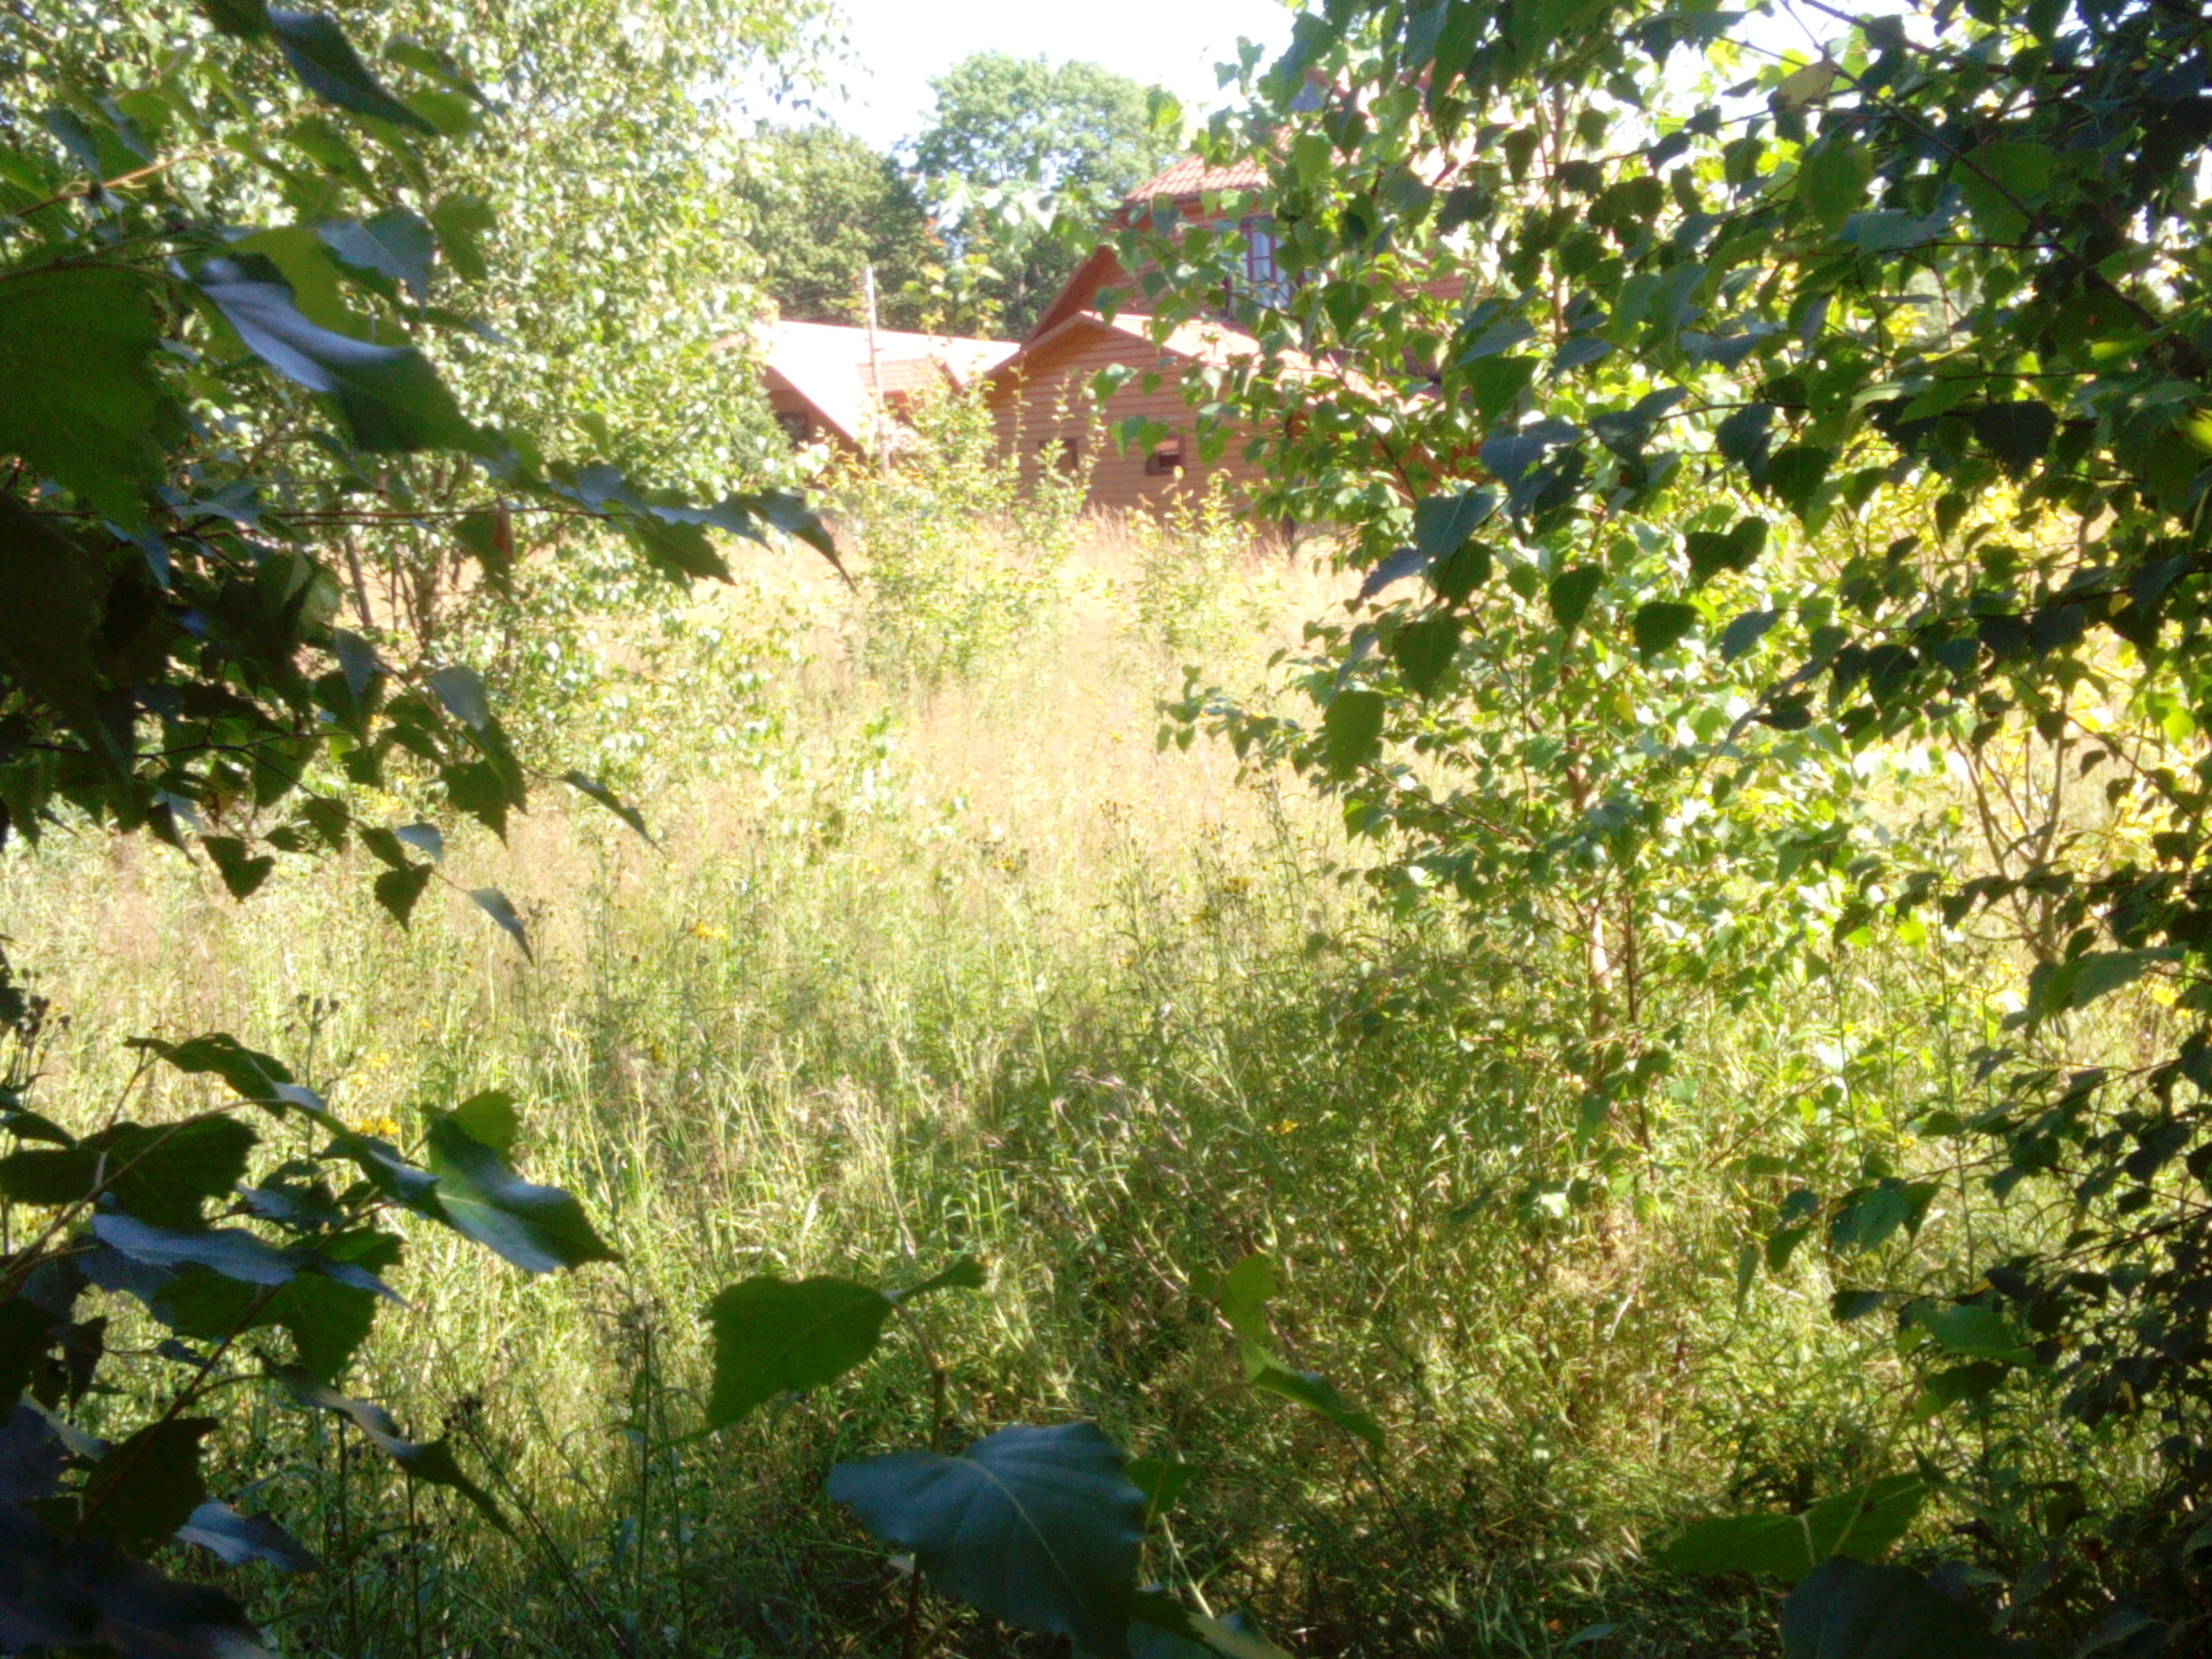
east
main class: Woodland
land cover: Broadleaved woodland
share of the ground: 25 - 50 %
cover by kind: herbaceous plants 75 %, broadleaved forest trees 25 %
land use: Semi-natural and natural areas not in use
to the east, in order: Broadleaved woodland; Grassland without tree/shrub cover; Artificial constructions in urban areas; Broadleaved woodland; Ditches and canals; Broadleaved woodland; Inland fresh water bodies; Grassland without tree/shrub cover; Artificial constructions in urban areas
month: August
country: LV
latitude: 56.9039
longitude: 21.9185
